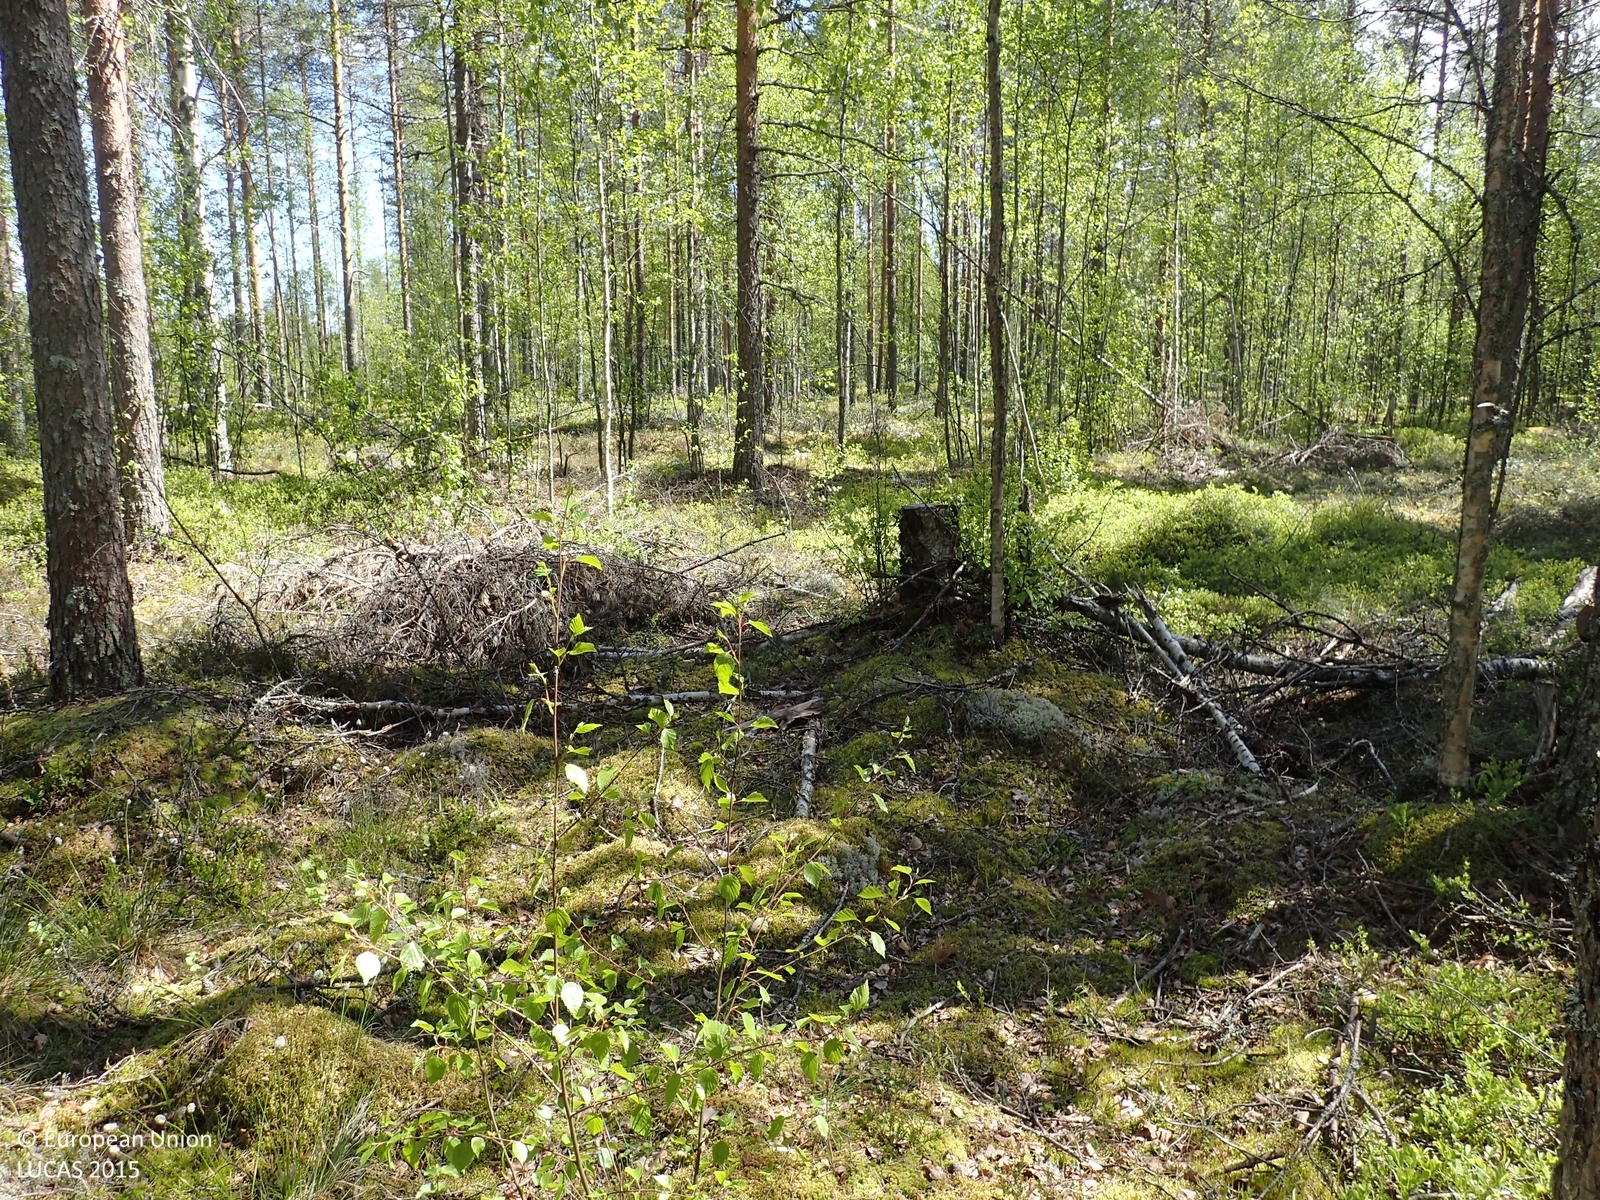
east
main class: Woodland
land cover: Pine dominated coniferous woodland
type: boreal forest
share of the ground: > 75 %
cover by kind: coniferous forest trees 60 %, broadleaved forest trees 20 %, shrubs 15 %, lichens and mosses 5 %
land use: Forestry
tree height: > 5 m
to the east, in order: Pine dominated coniferous woodland; Ditches and canals; Pine dominated coniferous woodland; Ditches and canals; Pine dominated coniferous woodland; Pine dominated mixed woodland; Pine dominated coniferous woodland; Pine dominated mixed woodland
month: June
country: FI
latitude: 62.2184
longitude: 22.2668
